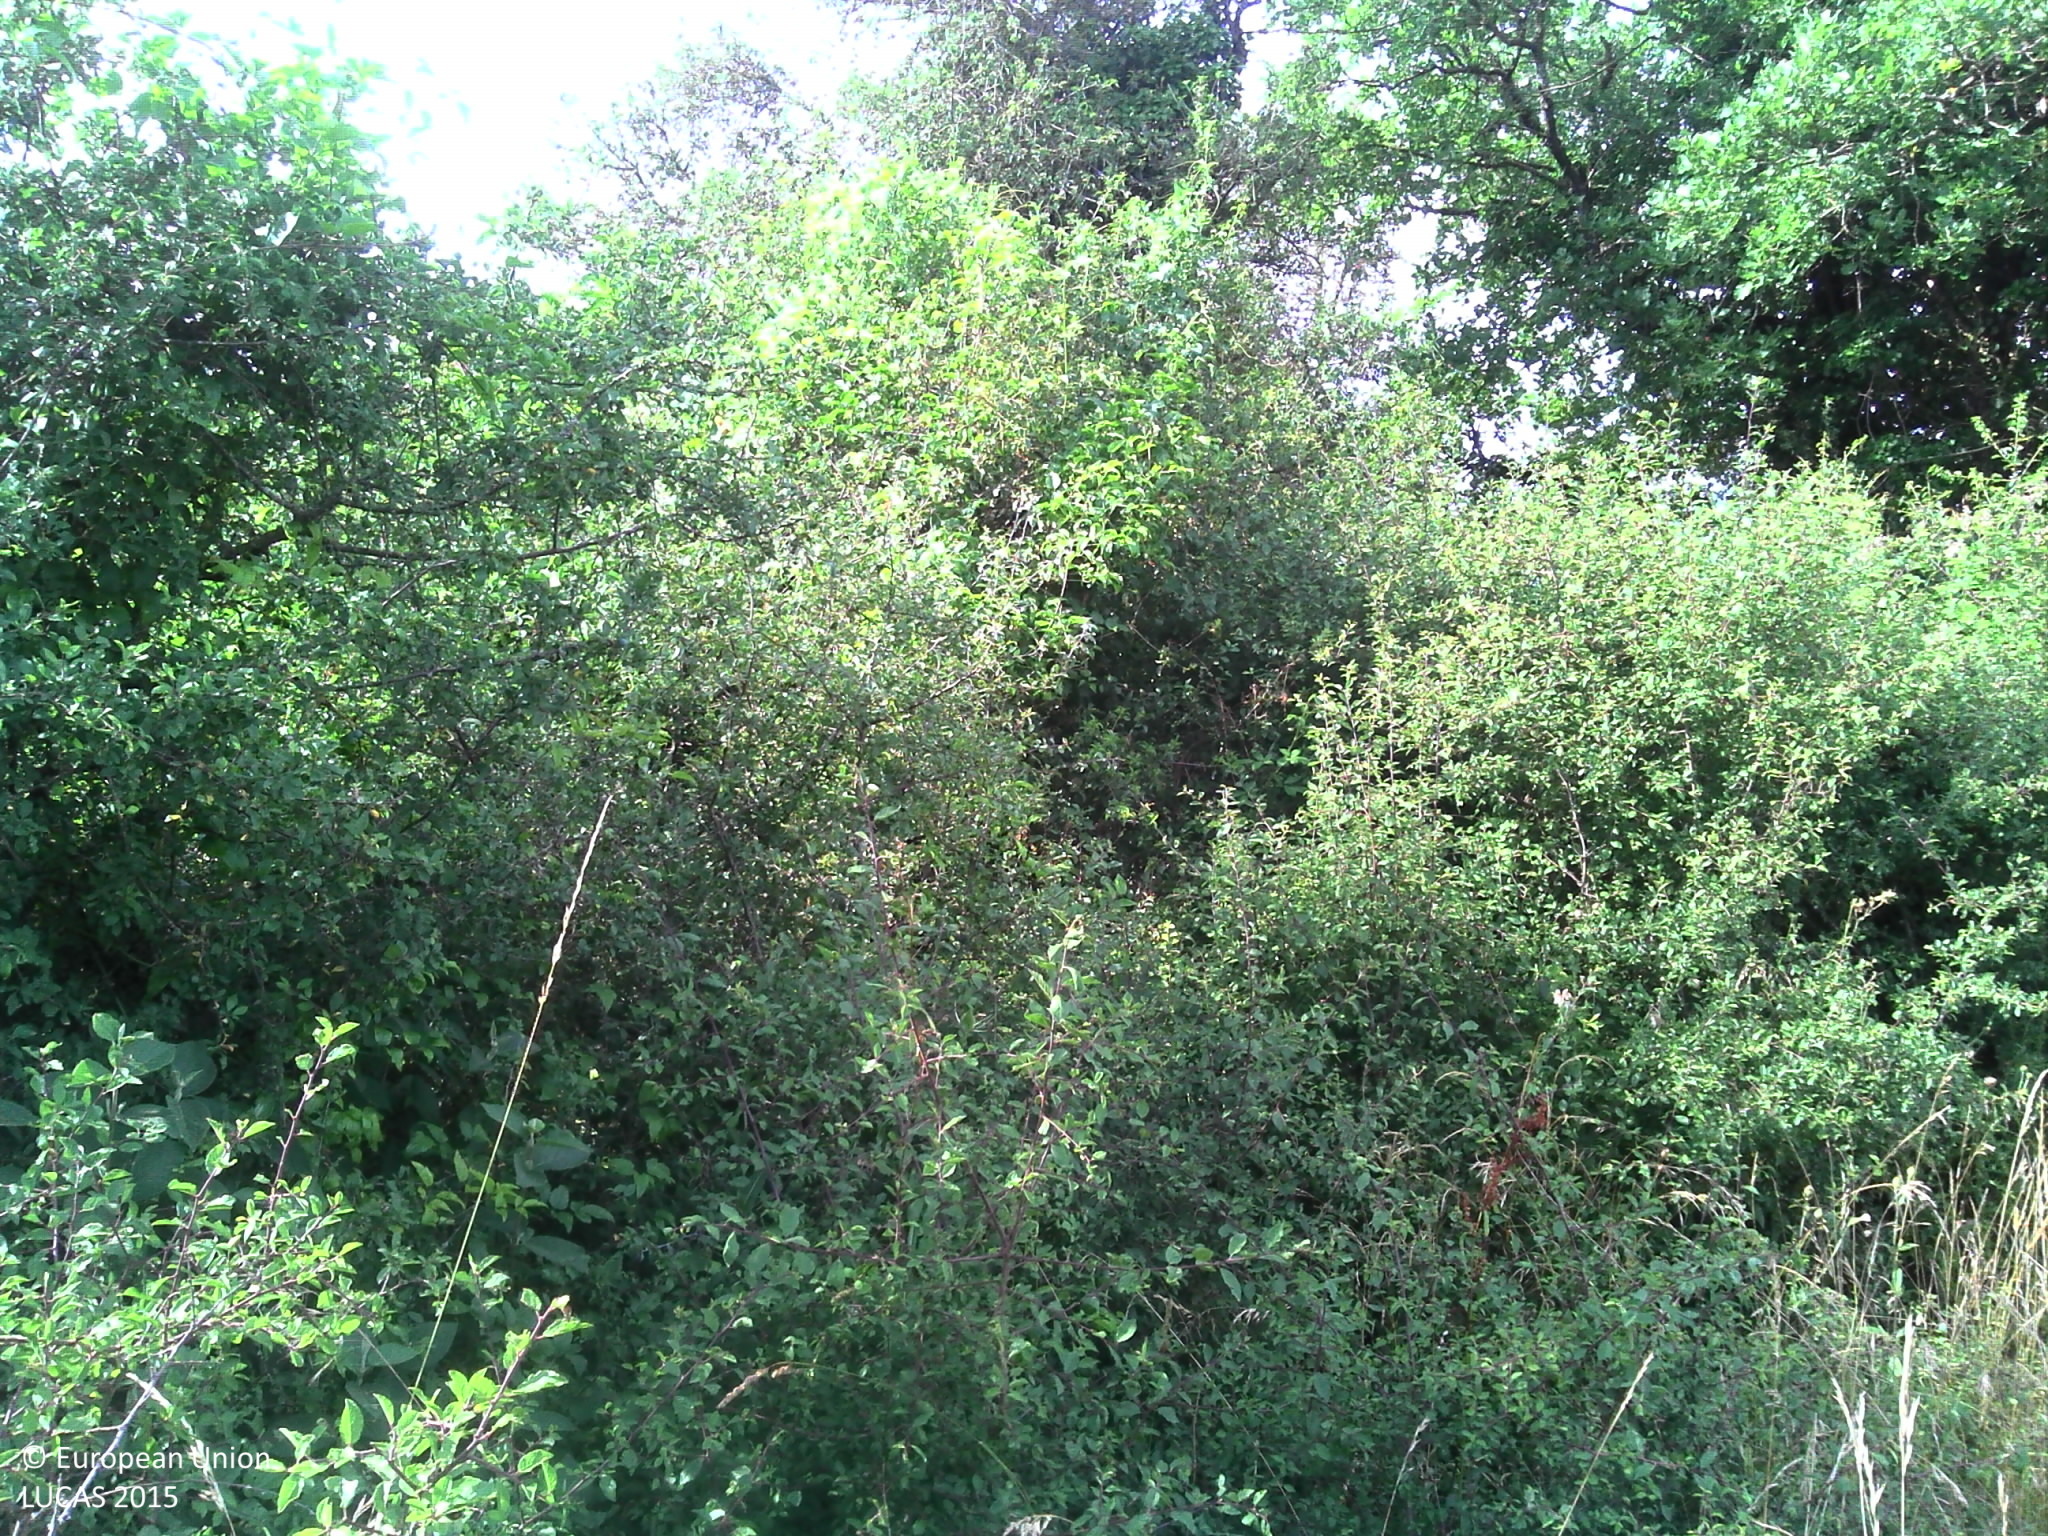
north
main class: Shrubland
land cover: Shrubland with sparse tree cover
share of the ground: > 75 %
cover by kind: shrubs 95 %, broadleaved forest trees 5 %
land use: Abandoned areas
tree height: < 5 m
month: June
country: FR
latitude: 44.0896
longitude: 1.9213
